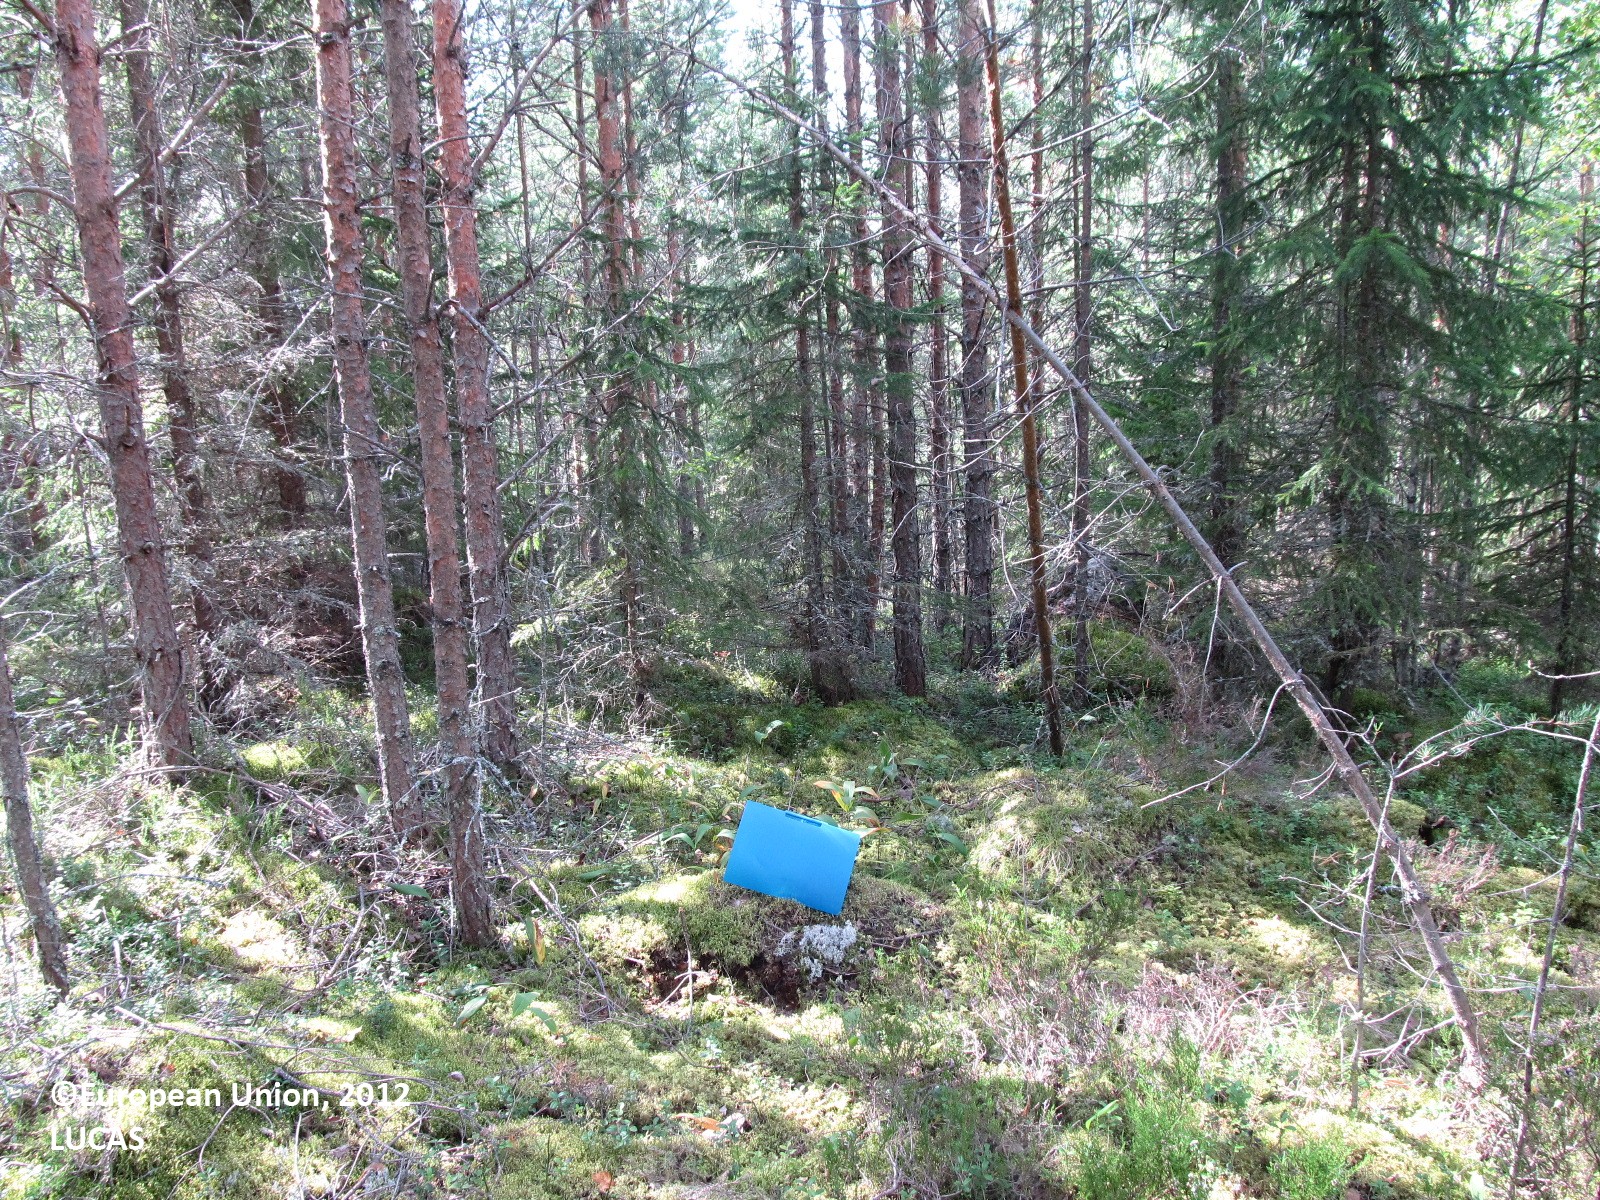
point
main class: Woodland
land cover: Other coniferous woodland
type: boreal forest
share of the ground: 50 - 75 %
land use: Forestry
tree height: > 5 m
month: August
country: FI
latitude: 62.3929
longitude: 27.6399
